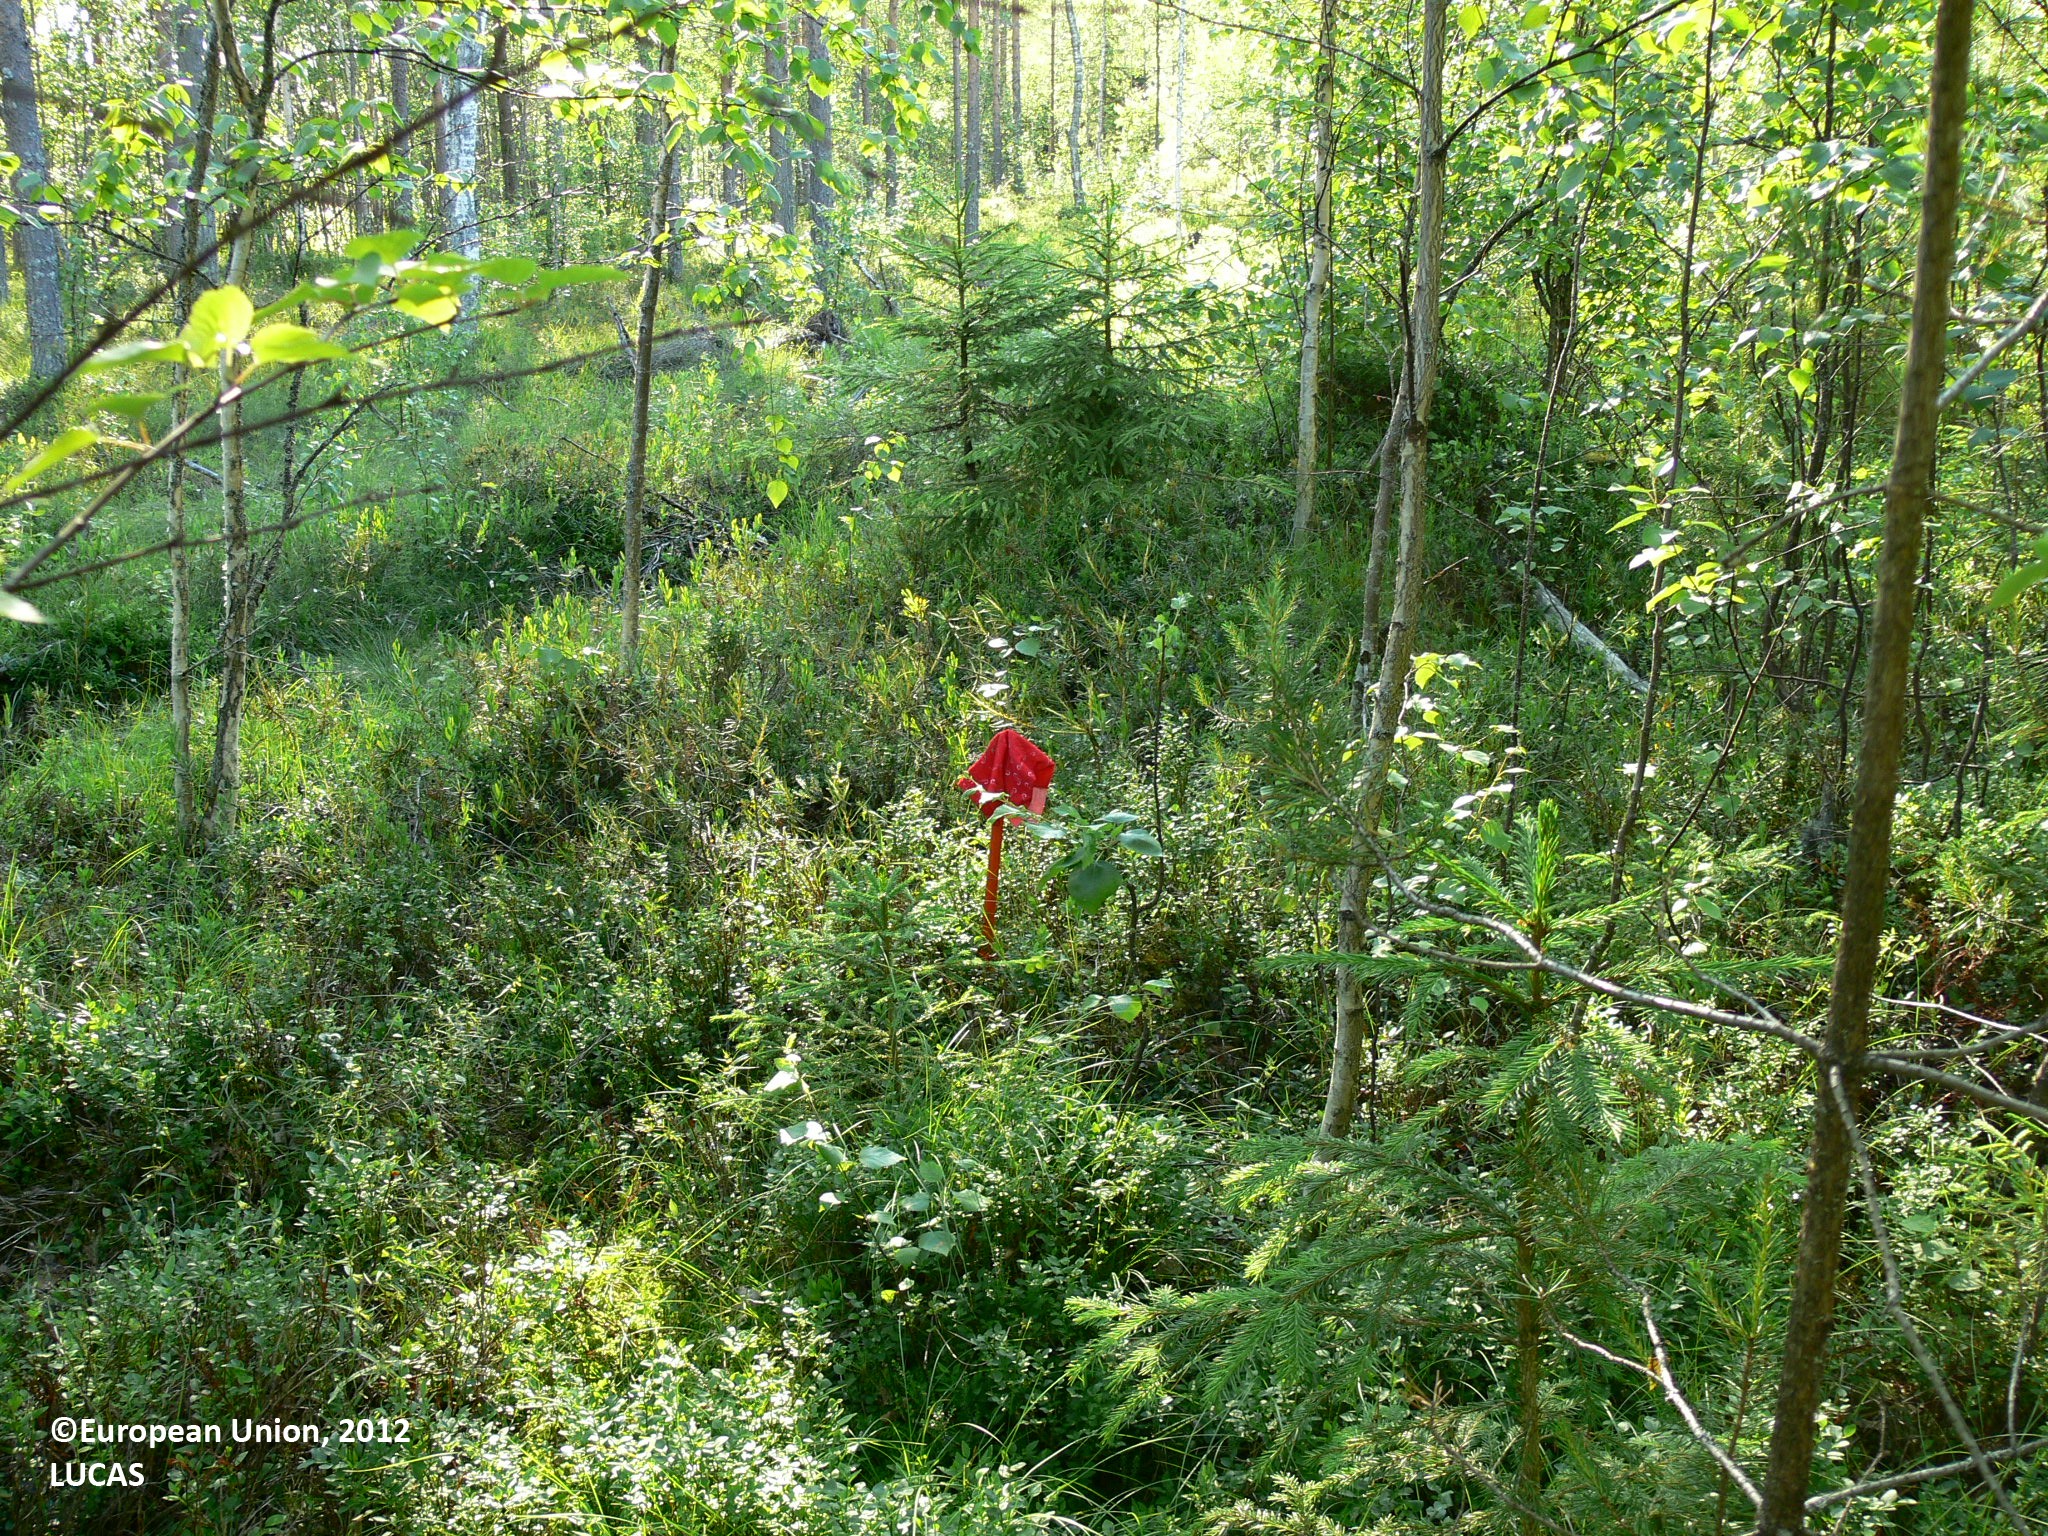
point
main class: Woodland
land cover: Pine dominated mixed woodland
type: boreal forest
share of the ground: > 75 %
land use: Forestry
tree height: > 5 m
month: July
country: FI
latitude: 62.8842
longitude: 30.7619
